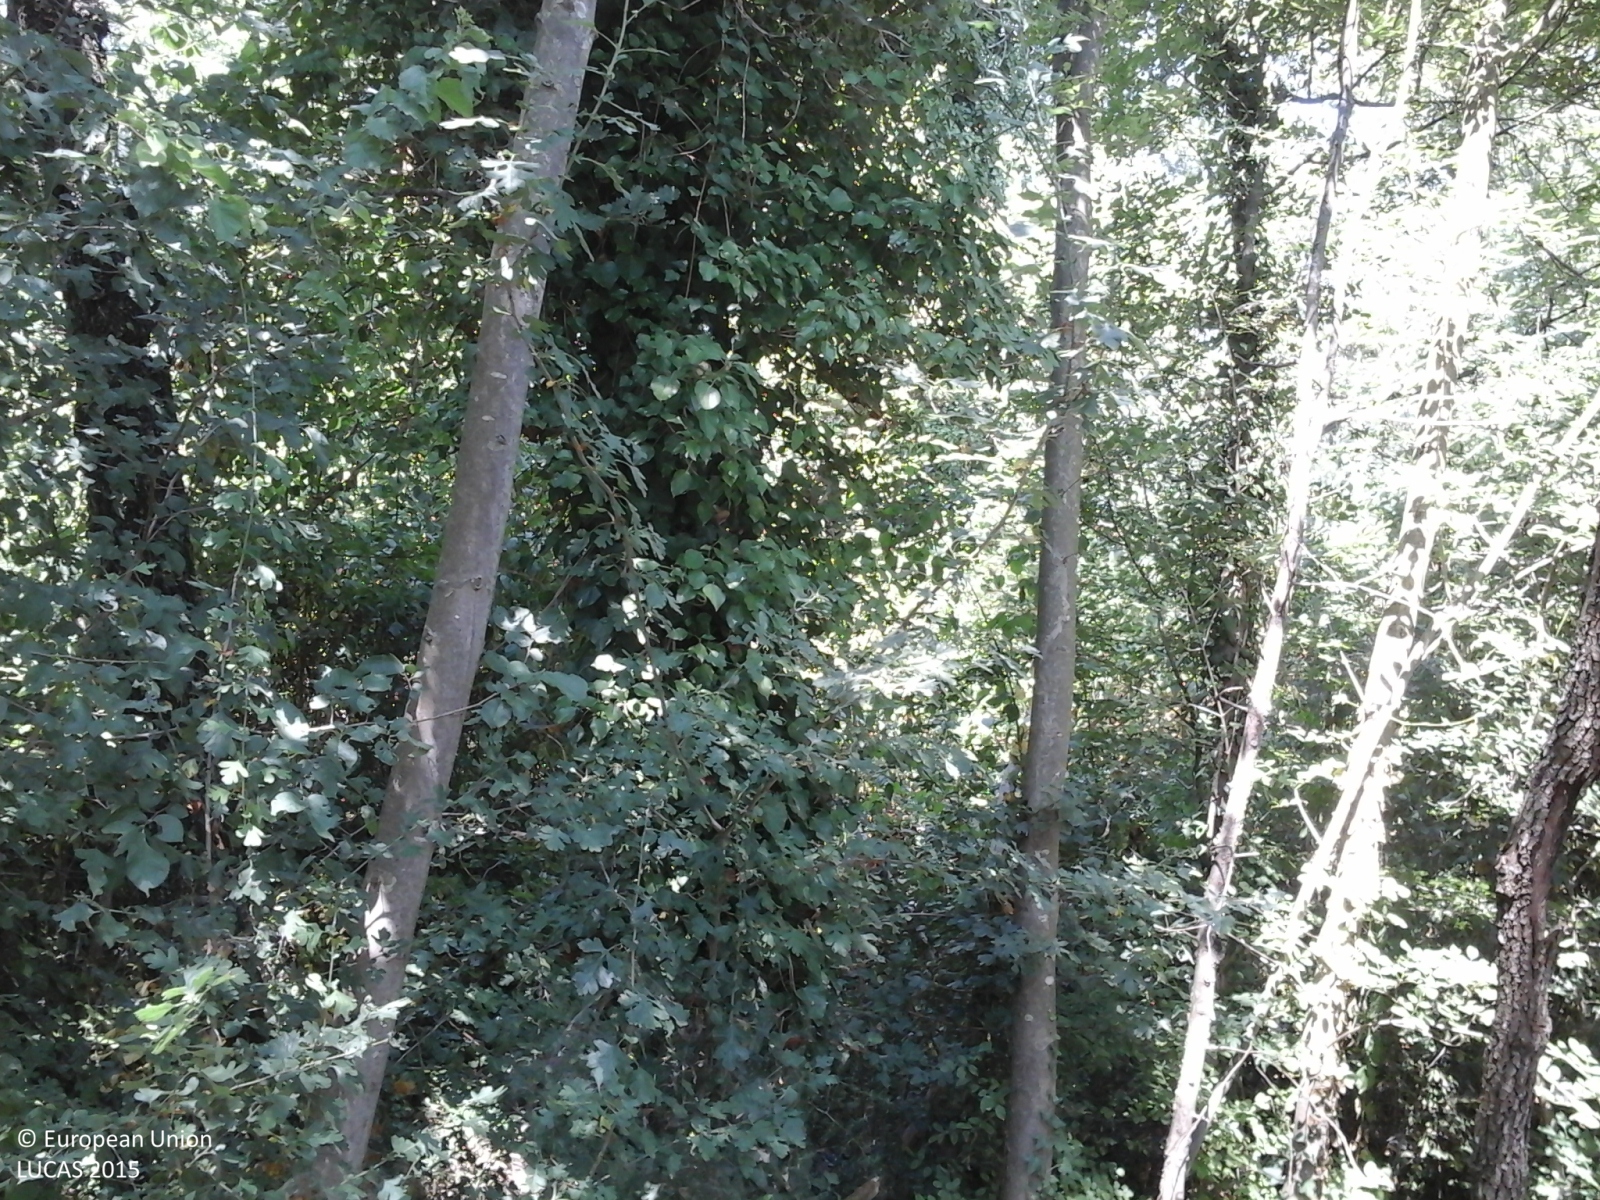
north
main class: Woodland
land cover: Broadleaved woodland
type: mesophytic deciduous forest
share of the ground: > 75 %
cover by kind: broadleaved forest trees 100 %
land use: Forestry
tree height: > 5 m
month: July
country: IT
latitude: 43.9450
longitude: 12.3492
